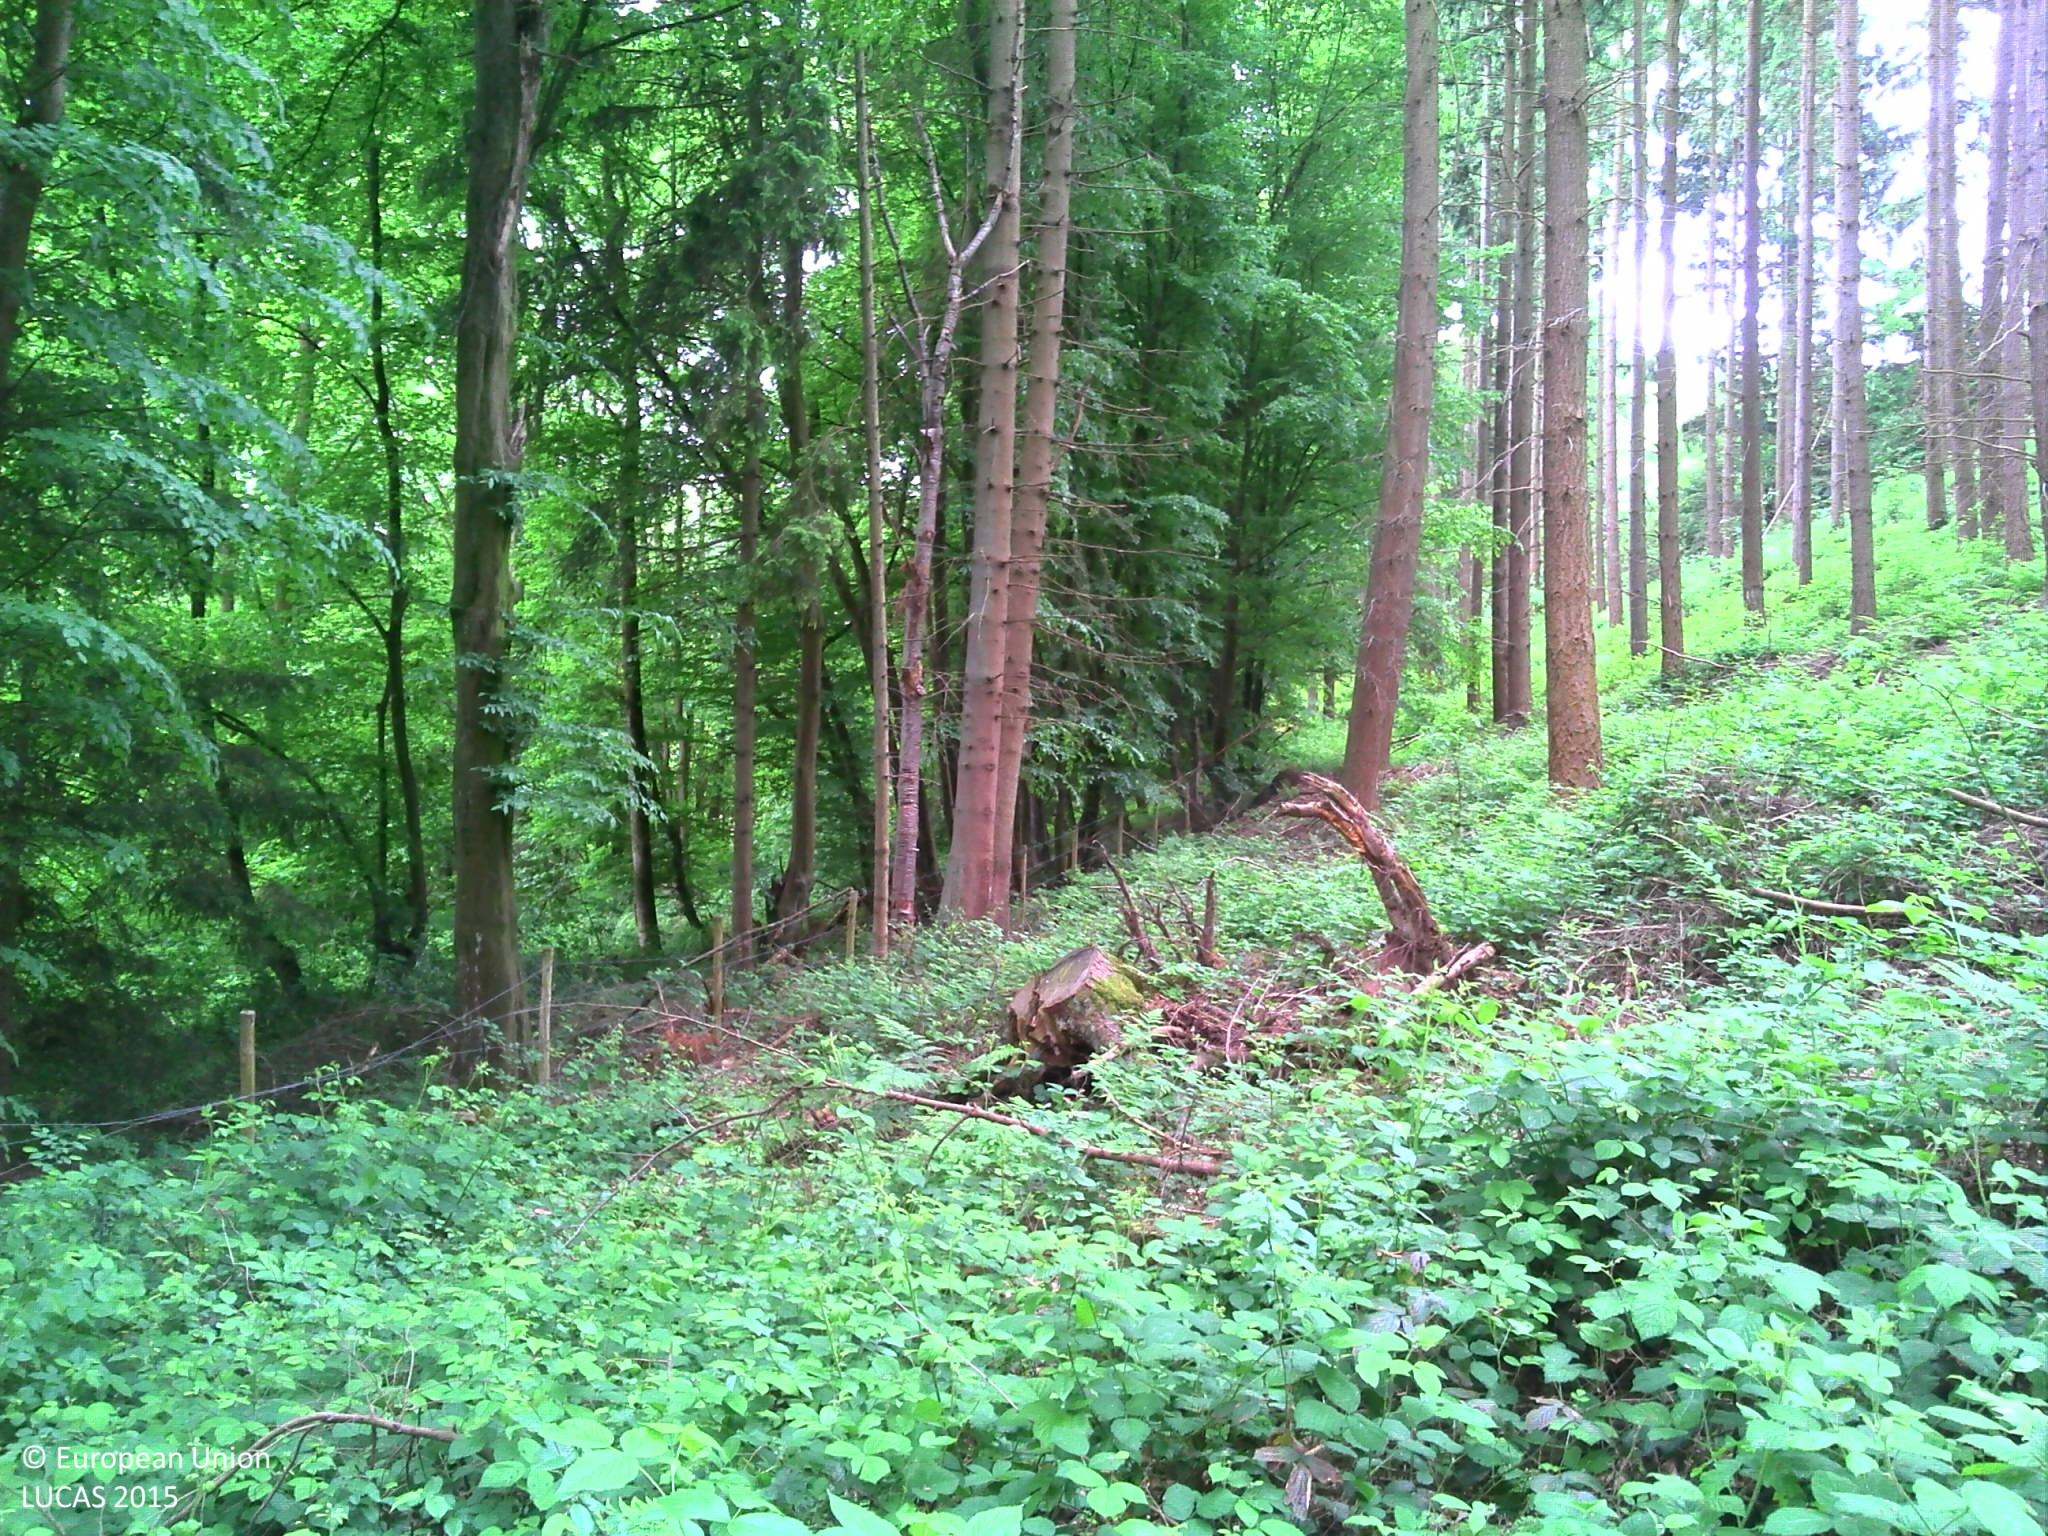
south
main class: Woodland
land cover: Other coniferous woodland
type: exotic forest
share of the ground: > 75 %
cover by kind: coniferous forest trees 90 %, herbaceous plants 10 %
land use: Forestry
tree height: > 5 m
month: June
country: BE
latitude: 50.3884
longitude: 5.6242
